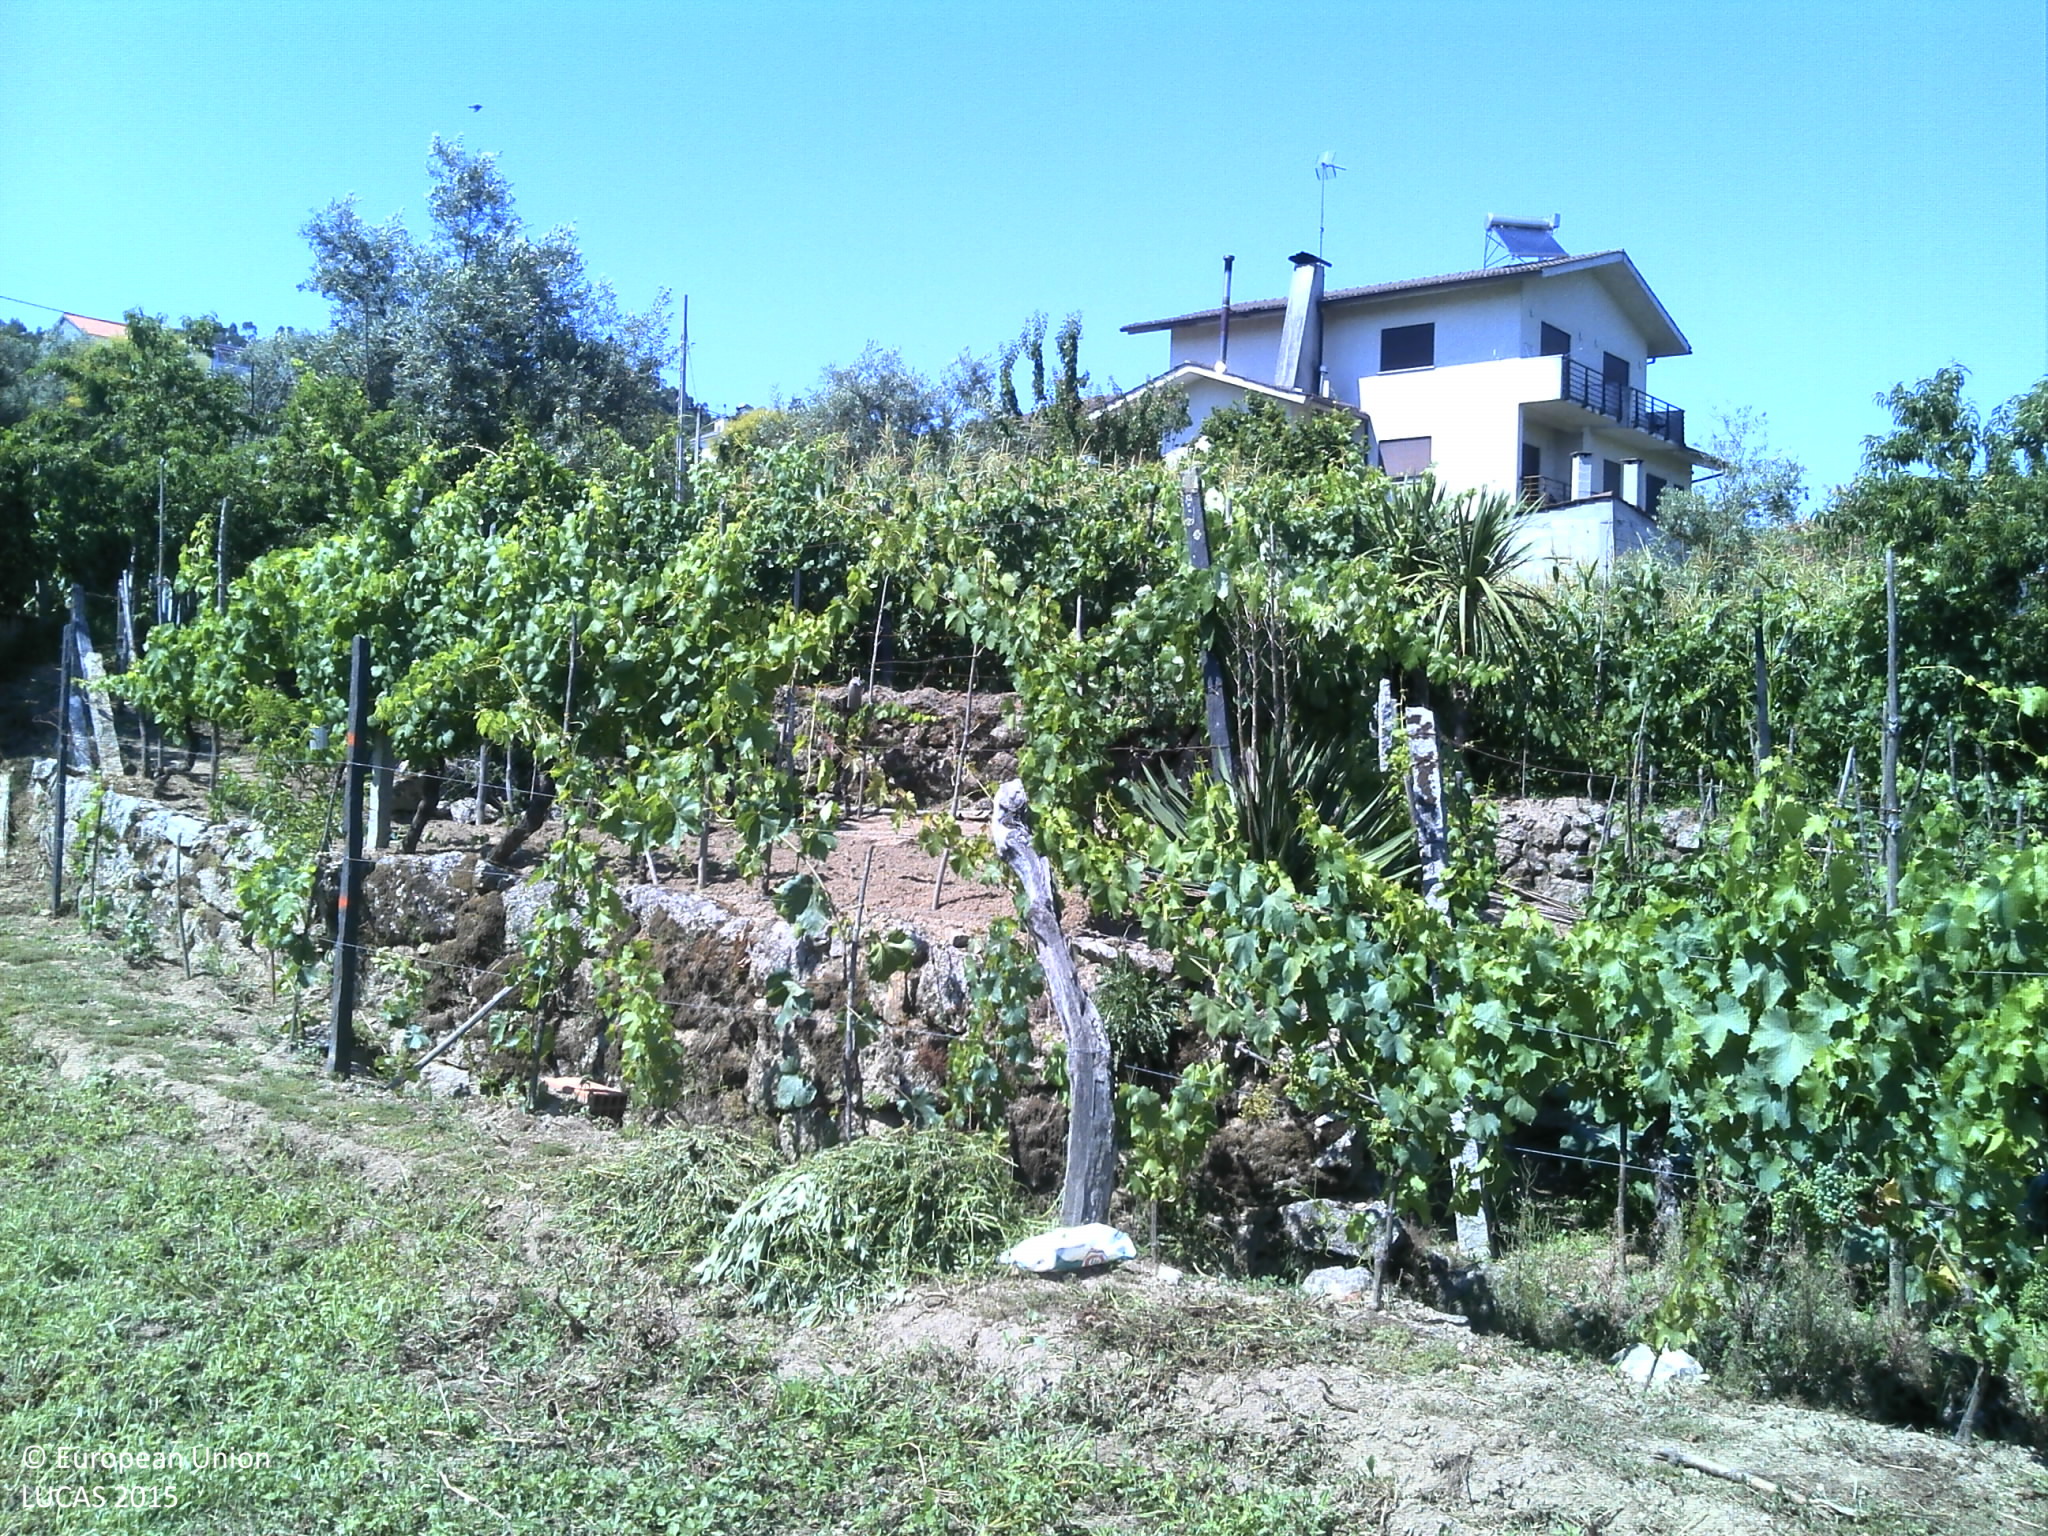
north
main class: Grassland
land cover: Spontaneously vegetated surfaces
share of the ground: > 75 %
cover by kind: herbaceous plants 90 %, unconsolidated bare surface 10 %
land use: Fallow land
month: June
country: PT
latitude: 40.6042
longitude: -7.9824
